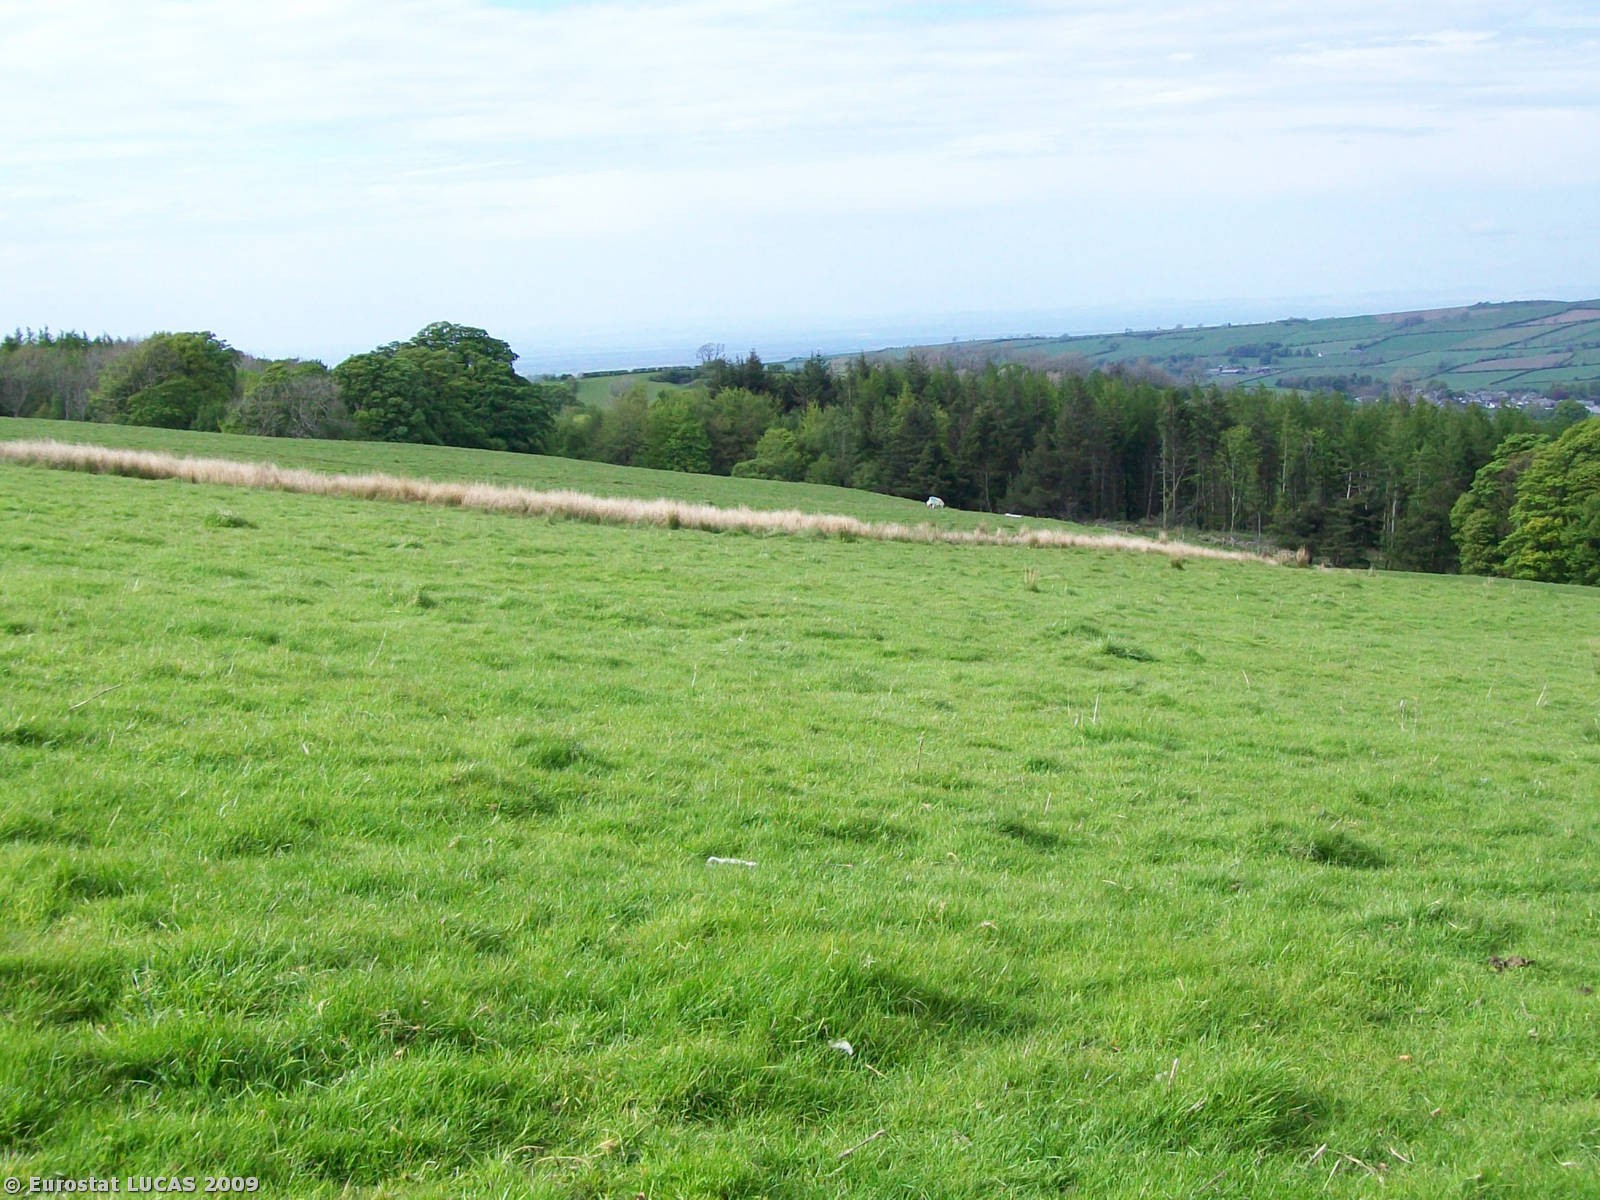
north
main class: Grassland
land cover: Grassland with sparse tree/shrub cover
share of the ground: > 75 %
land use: Agriculture (excluding fallow land and kitchen gardens)
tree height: > 5 m
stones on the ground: < 10 %
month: May
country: GB
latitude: 54.7181
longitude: -3.1935
